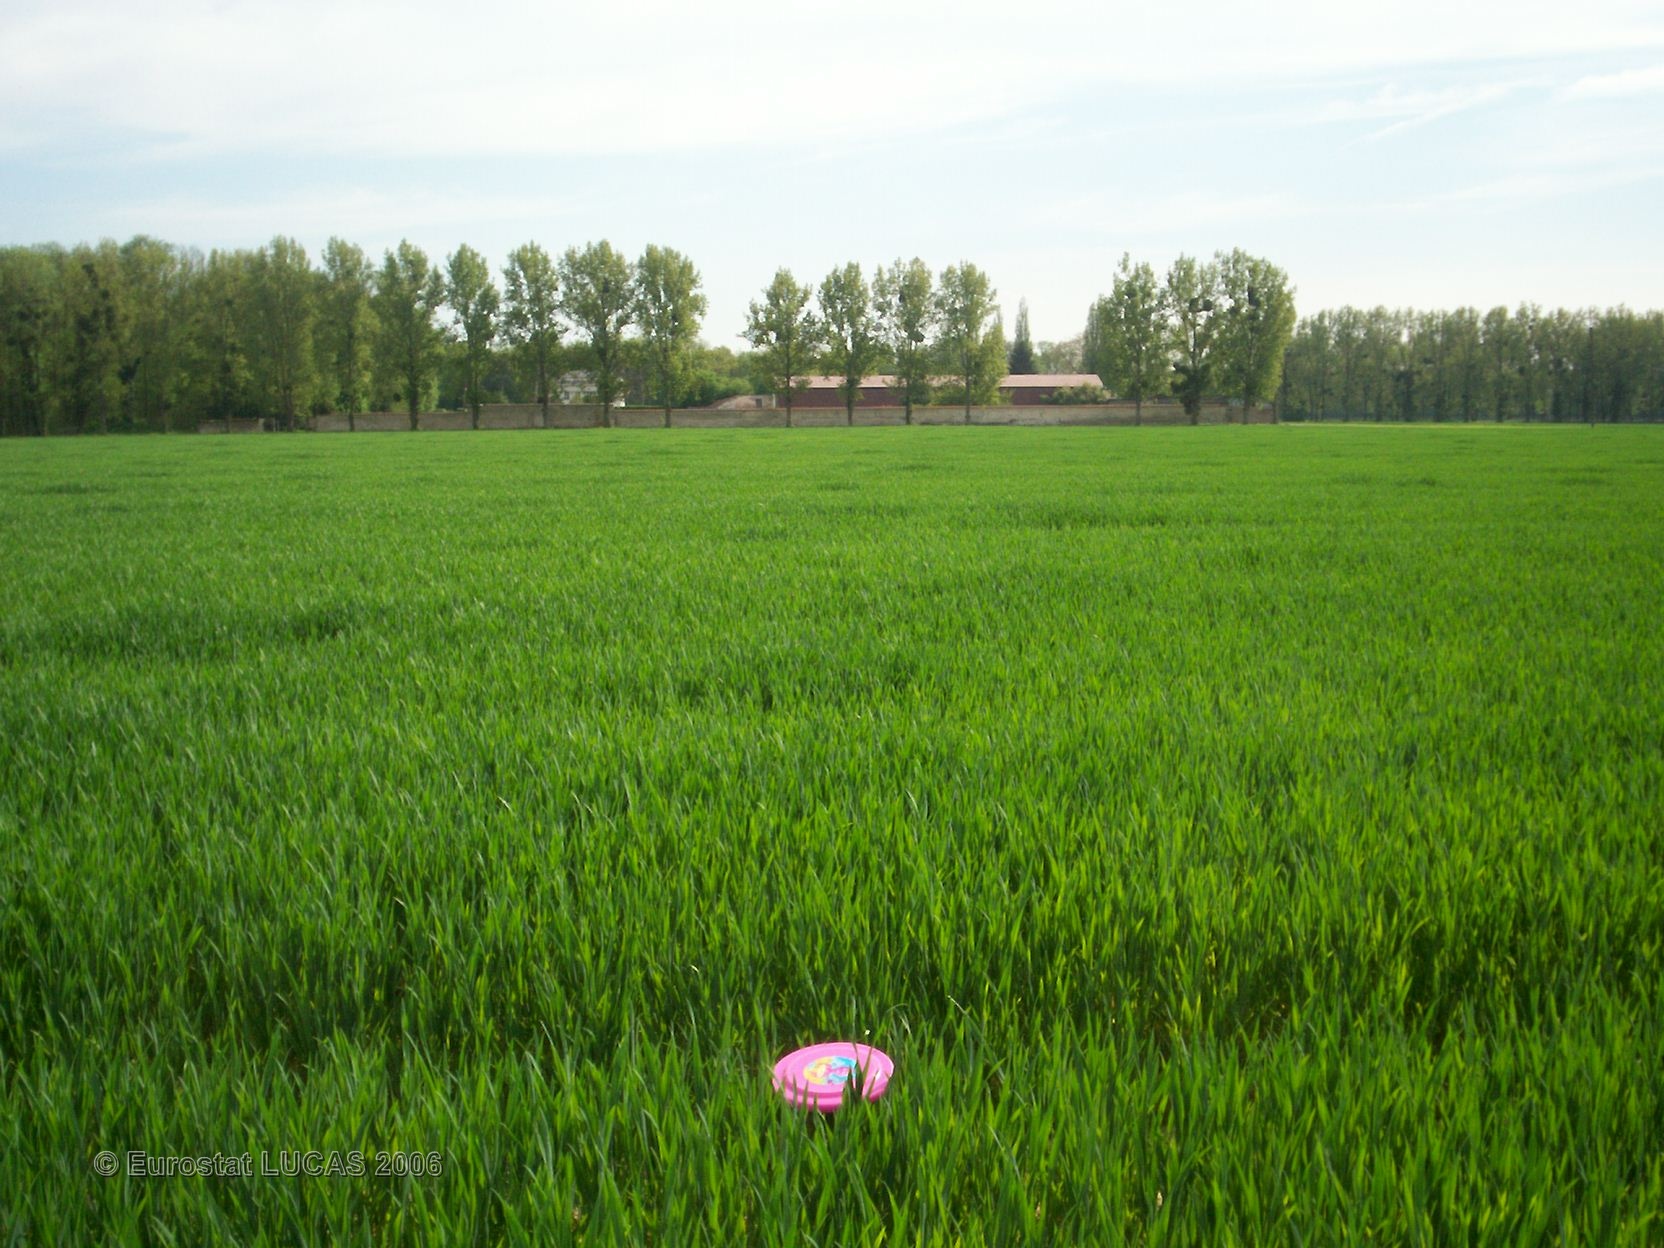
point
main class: Cropland
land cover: Common wheat
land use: Agriculture (excluding fallow land and kitchen gardens)
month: May
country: FR
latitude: 48.7285
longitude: 2.7988
